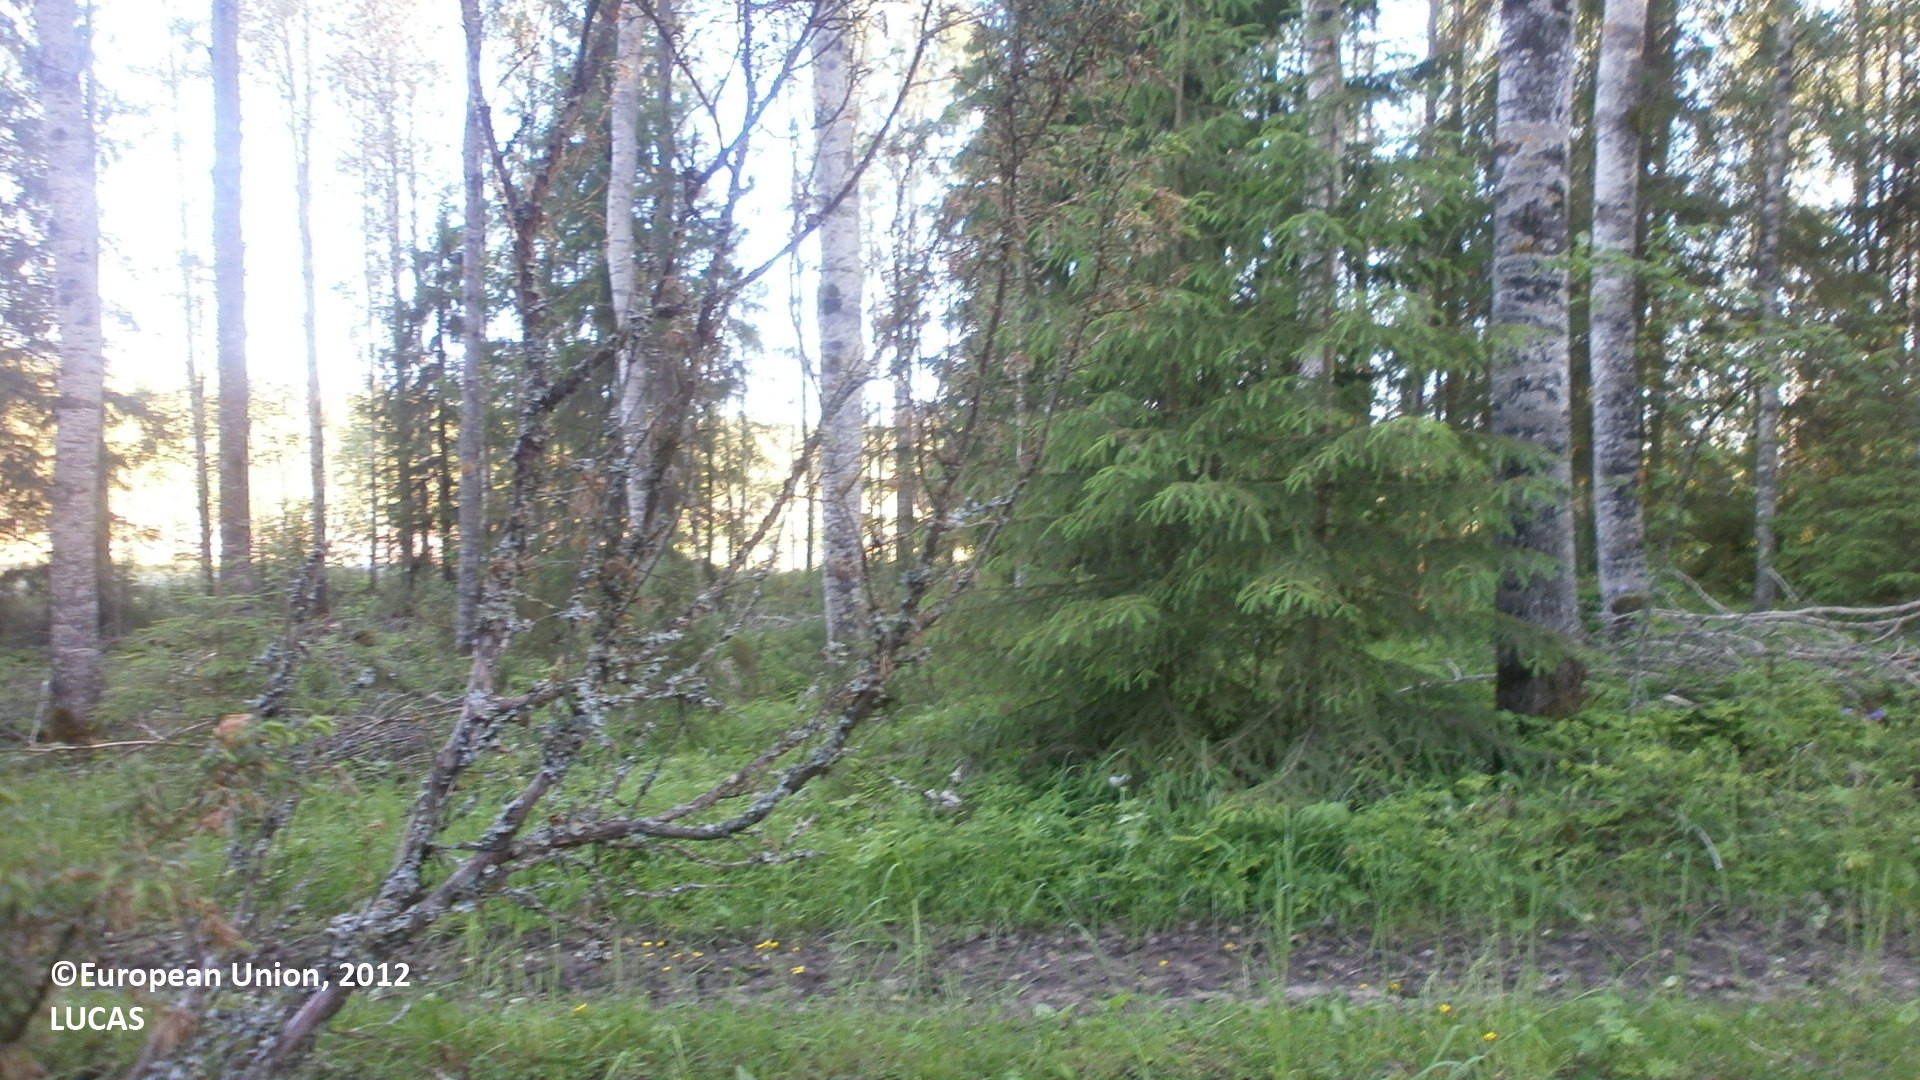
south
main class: Woodland
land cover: Other mixed woodland
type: boreal forest
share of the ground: > 75 %
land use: Amenities, museums, leisure
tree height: > 5 m
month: June
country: FI
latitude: 64.3121
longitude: 24.9467
